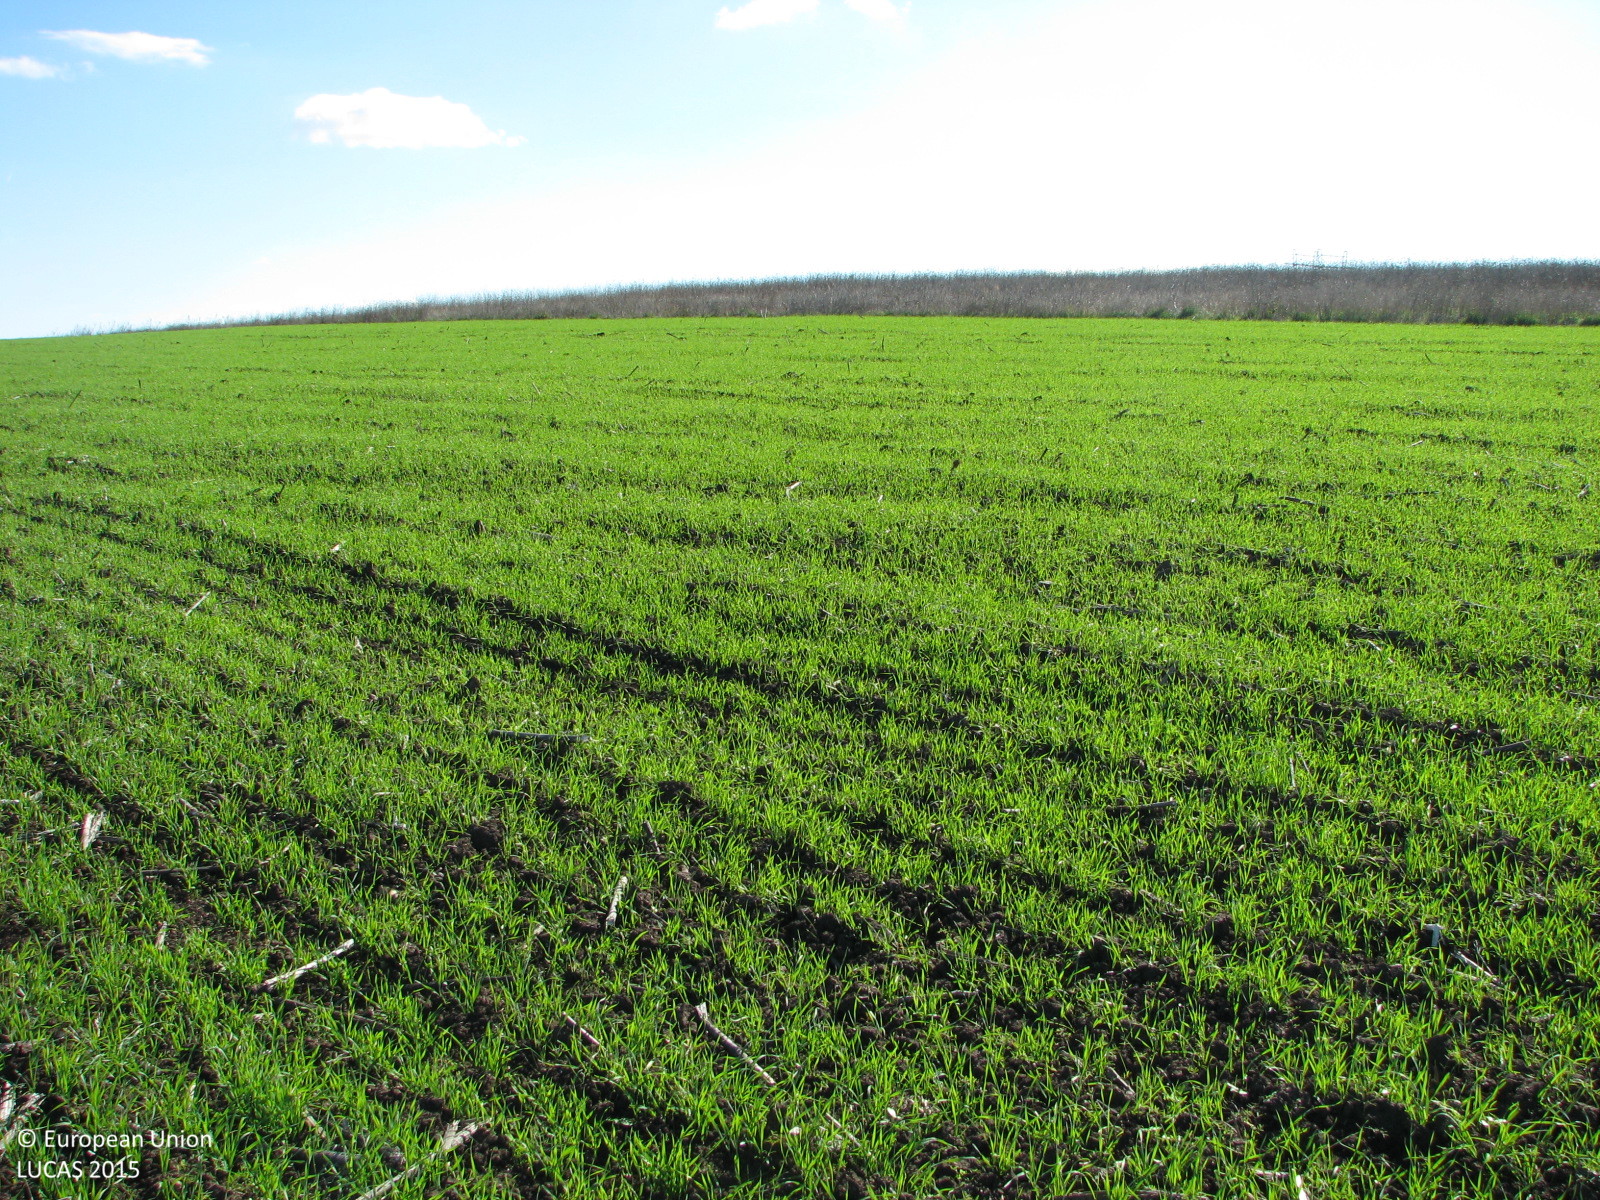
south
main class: Cropland
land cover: Common wheat
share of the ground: 50 - 75 %
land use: Agriculture (excluding fallow land and kitchen gardens)
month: October
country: BG
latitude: 42.1781
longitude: 26.2445
